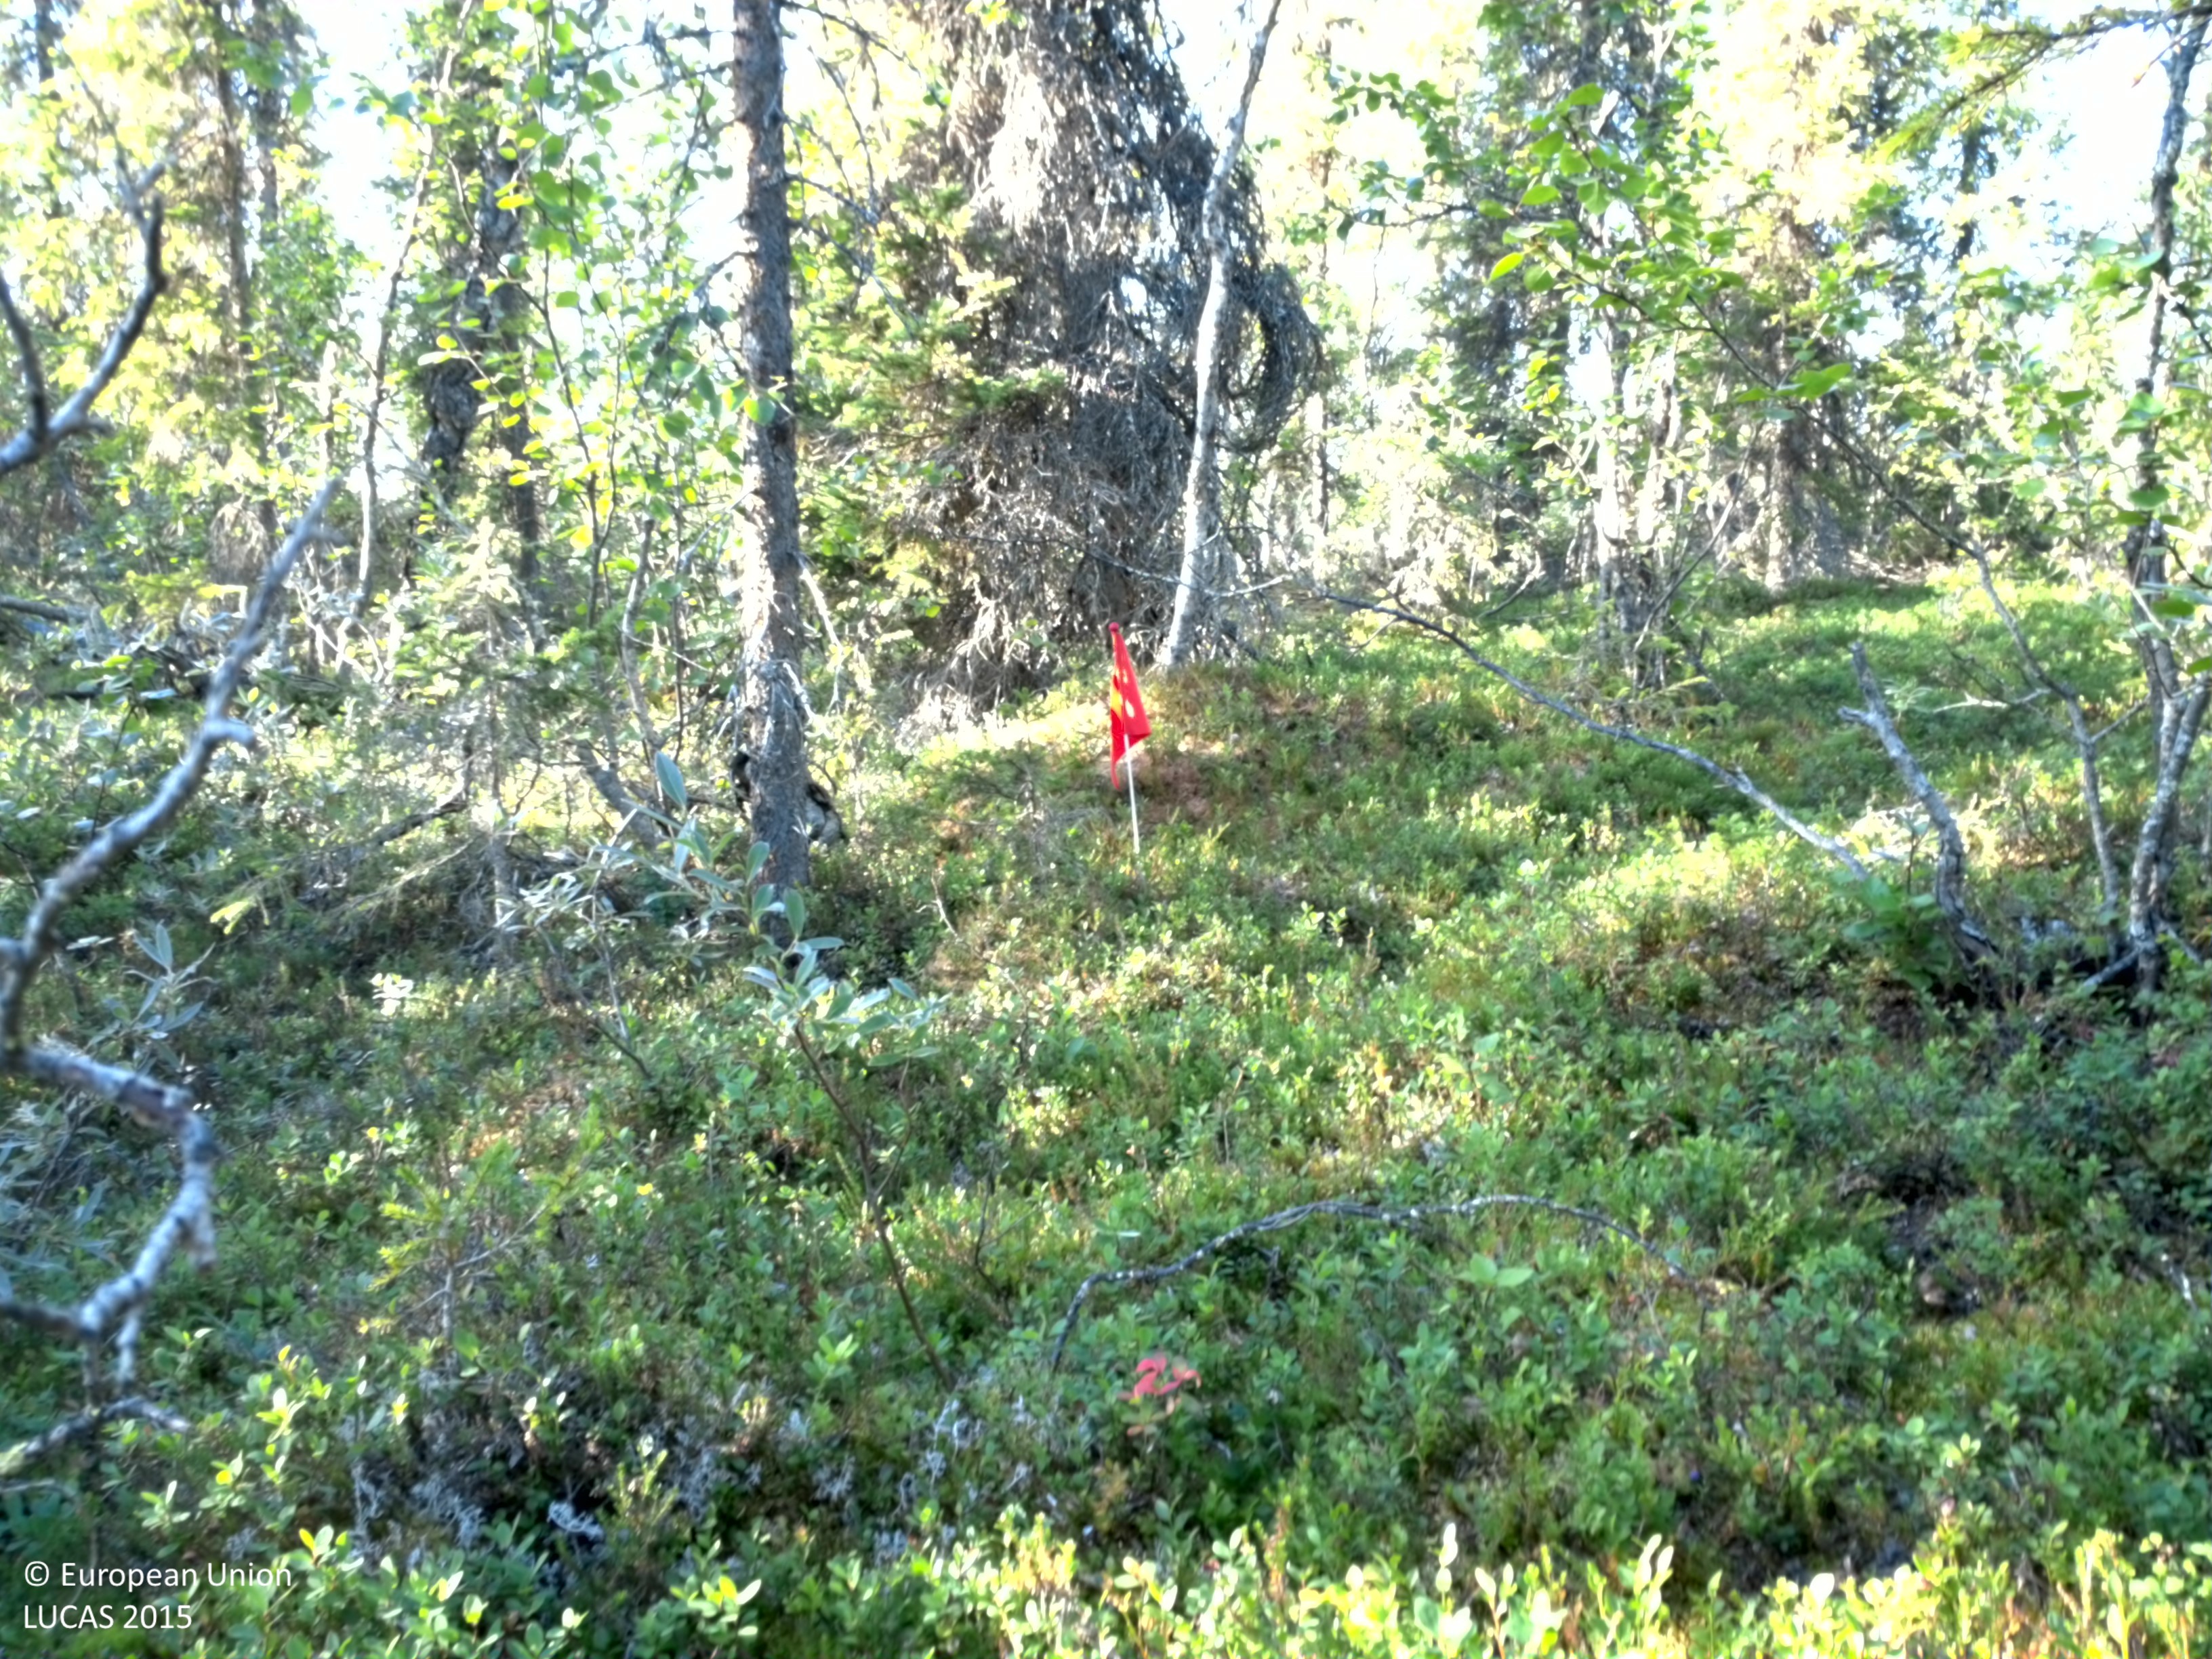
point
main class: Woodland
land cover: Pine dominated mixed woodland
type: boreal forest
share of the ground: 25 - 50 %
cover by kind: shrubs 60 %, coniferous forest trees 30 %, broadleaved forest trees 10 %
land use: Amenities, museums, leisure
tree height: > 5 m
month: August
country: SE
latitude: 66.9356
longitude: 18.8908
